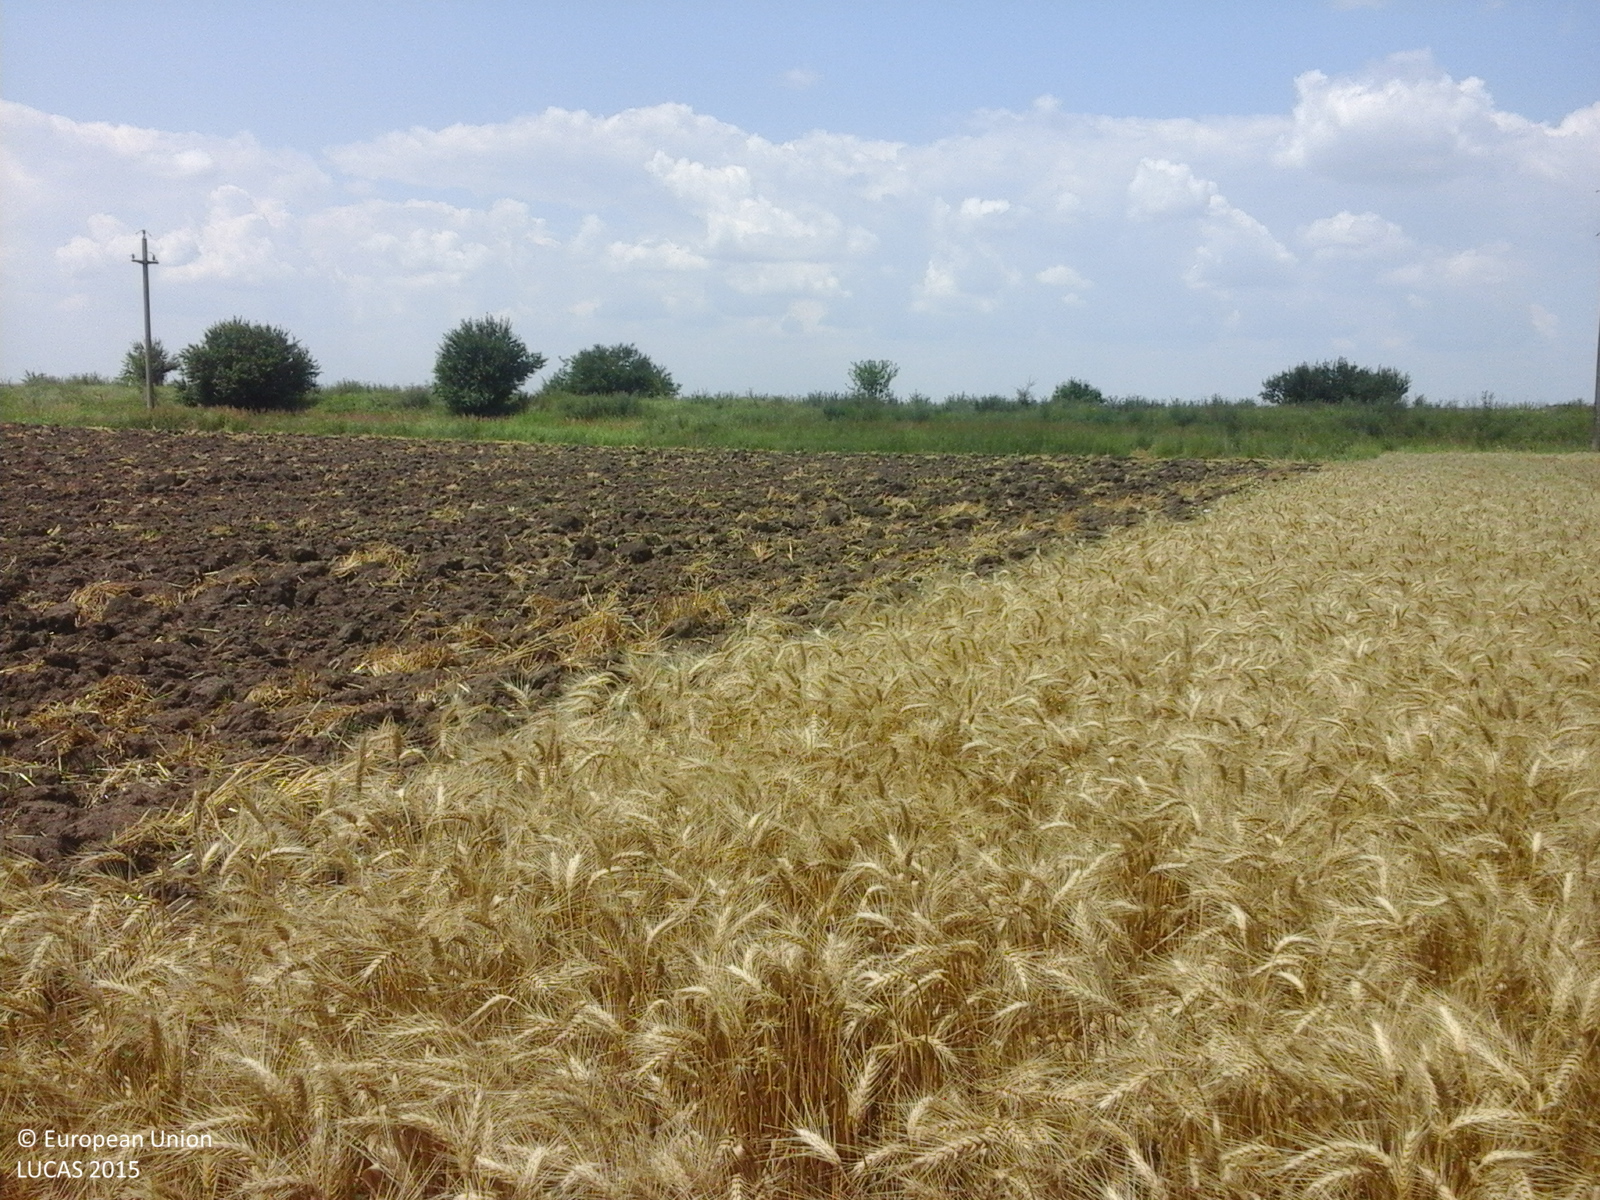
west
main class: Cropland
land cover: Common wheat
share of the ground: > 75 %
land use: Agriculture (excluding fallow land and kitchen gardens)
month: July
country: RO
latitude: 44.0710
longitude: 25.8909
